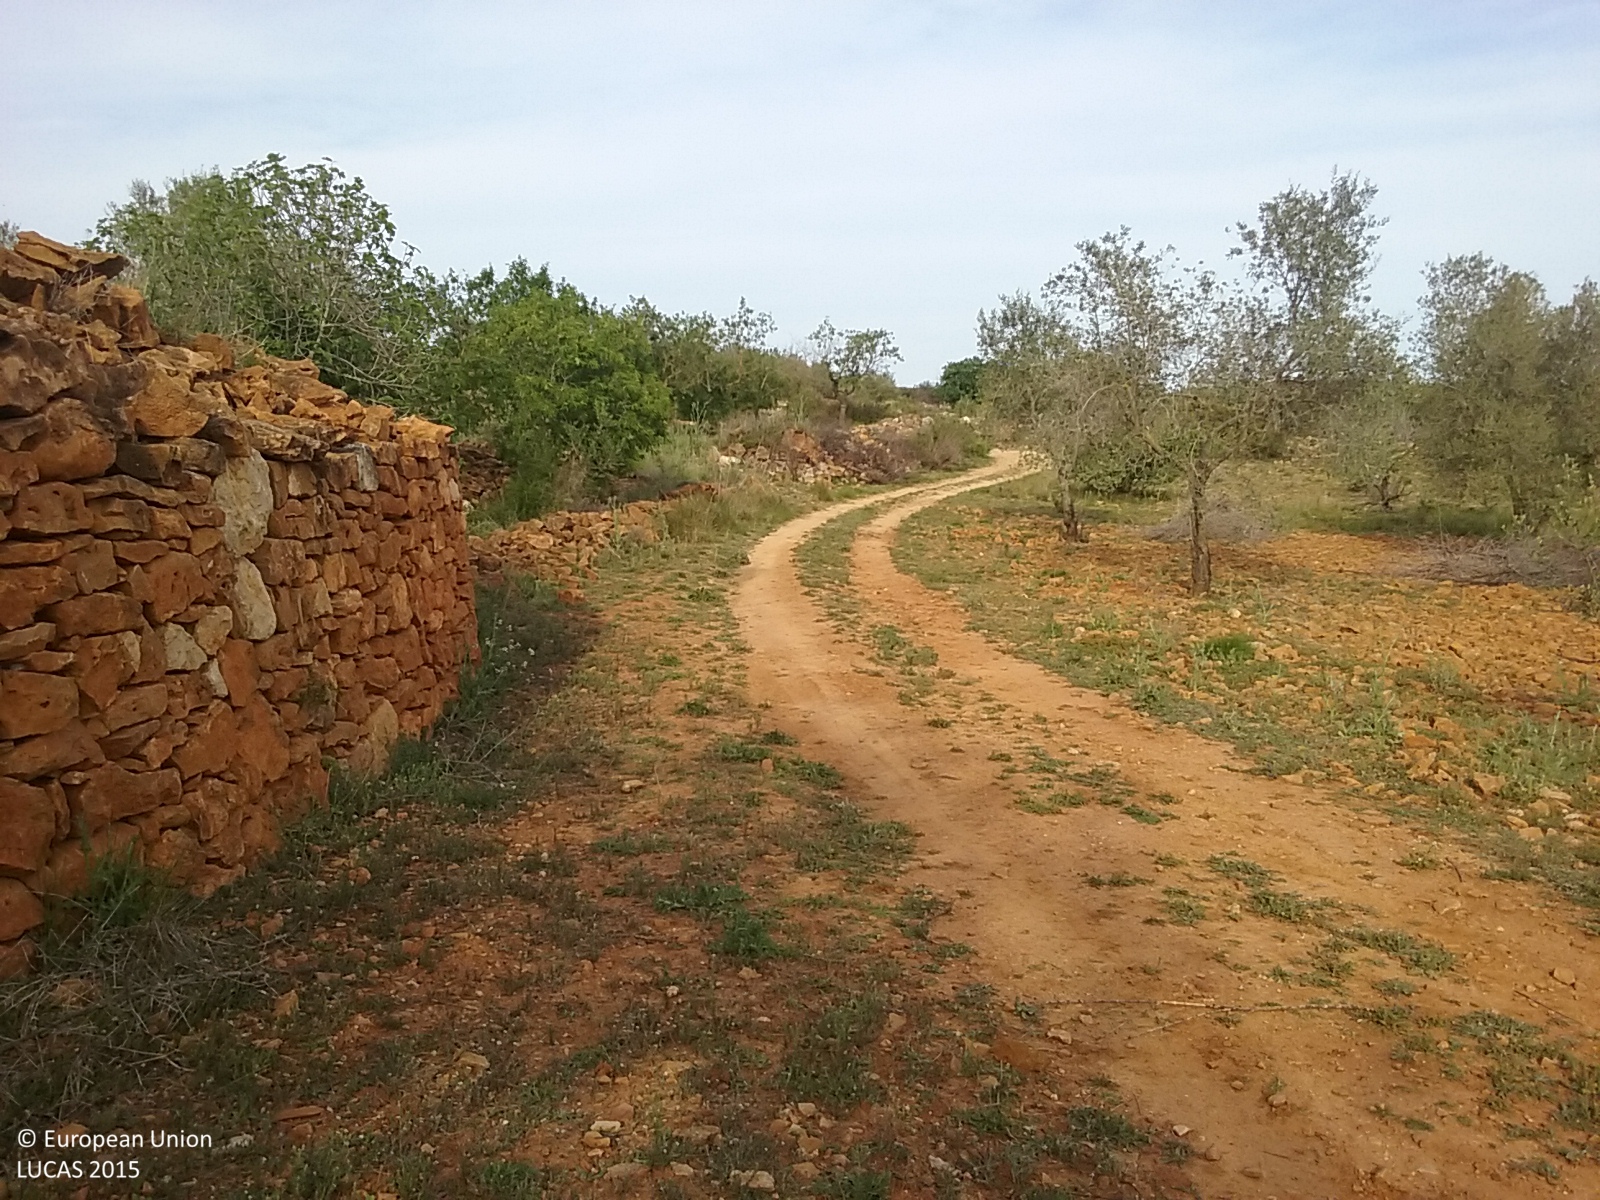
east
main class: Cropland
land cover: Olive groves
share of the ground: 25 - 50 %
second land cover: Grassland without tree/shrub cover
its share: 50 - 75 %
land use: Agriculture (excluding fallow land and kitchen gardens)
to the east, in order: Tracks; Olive groves; Grassland without tree/shrub cover; Tracks; Olive groves; Tracks; Dry stone walls; Olive groves; Dry stone walls; Olive groves; Groves; Dry stone walls; Nuts trees; Dry stone walls; Paved roads, cycling and walking lanes; Grass margins; Fences; Grassland with sparse tree/shrub cover
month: May
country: ES
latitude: 40.2175
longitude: 0.0680
